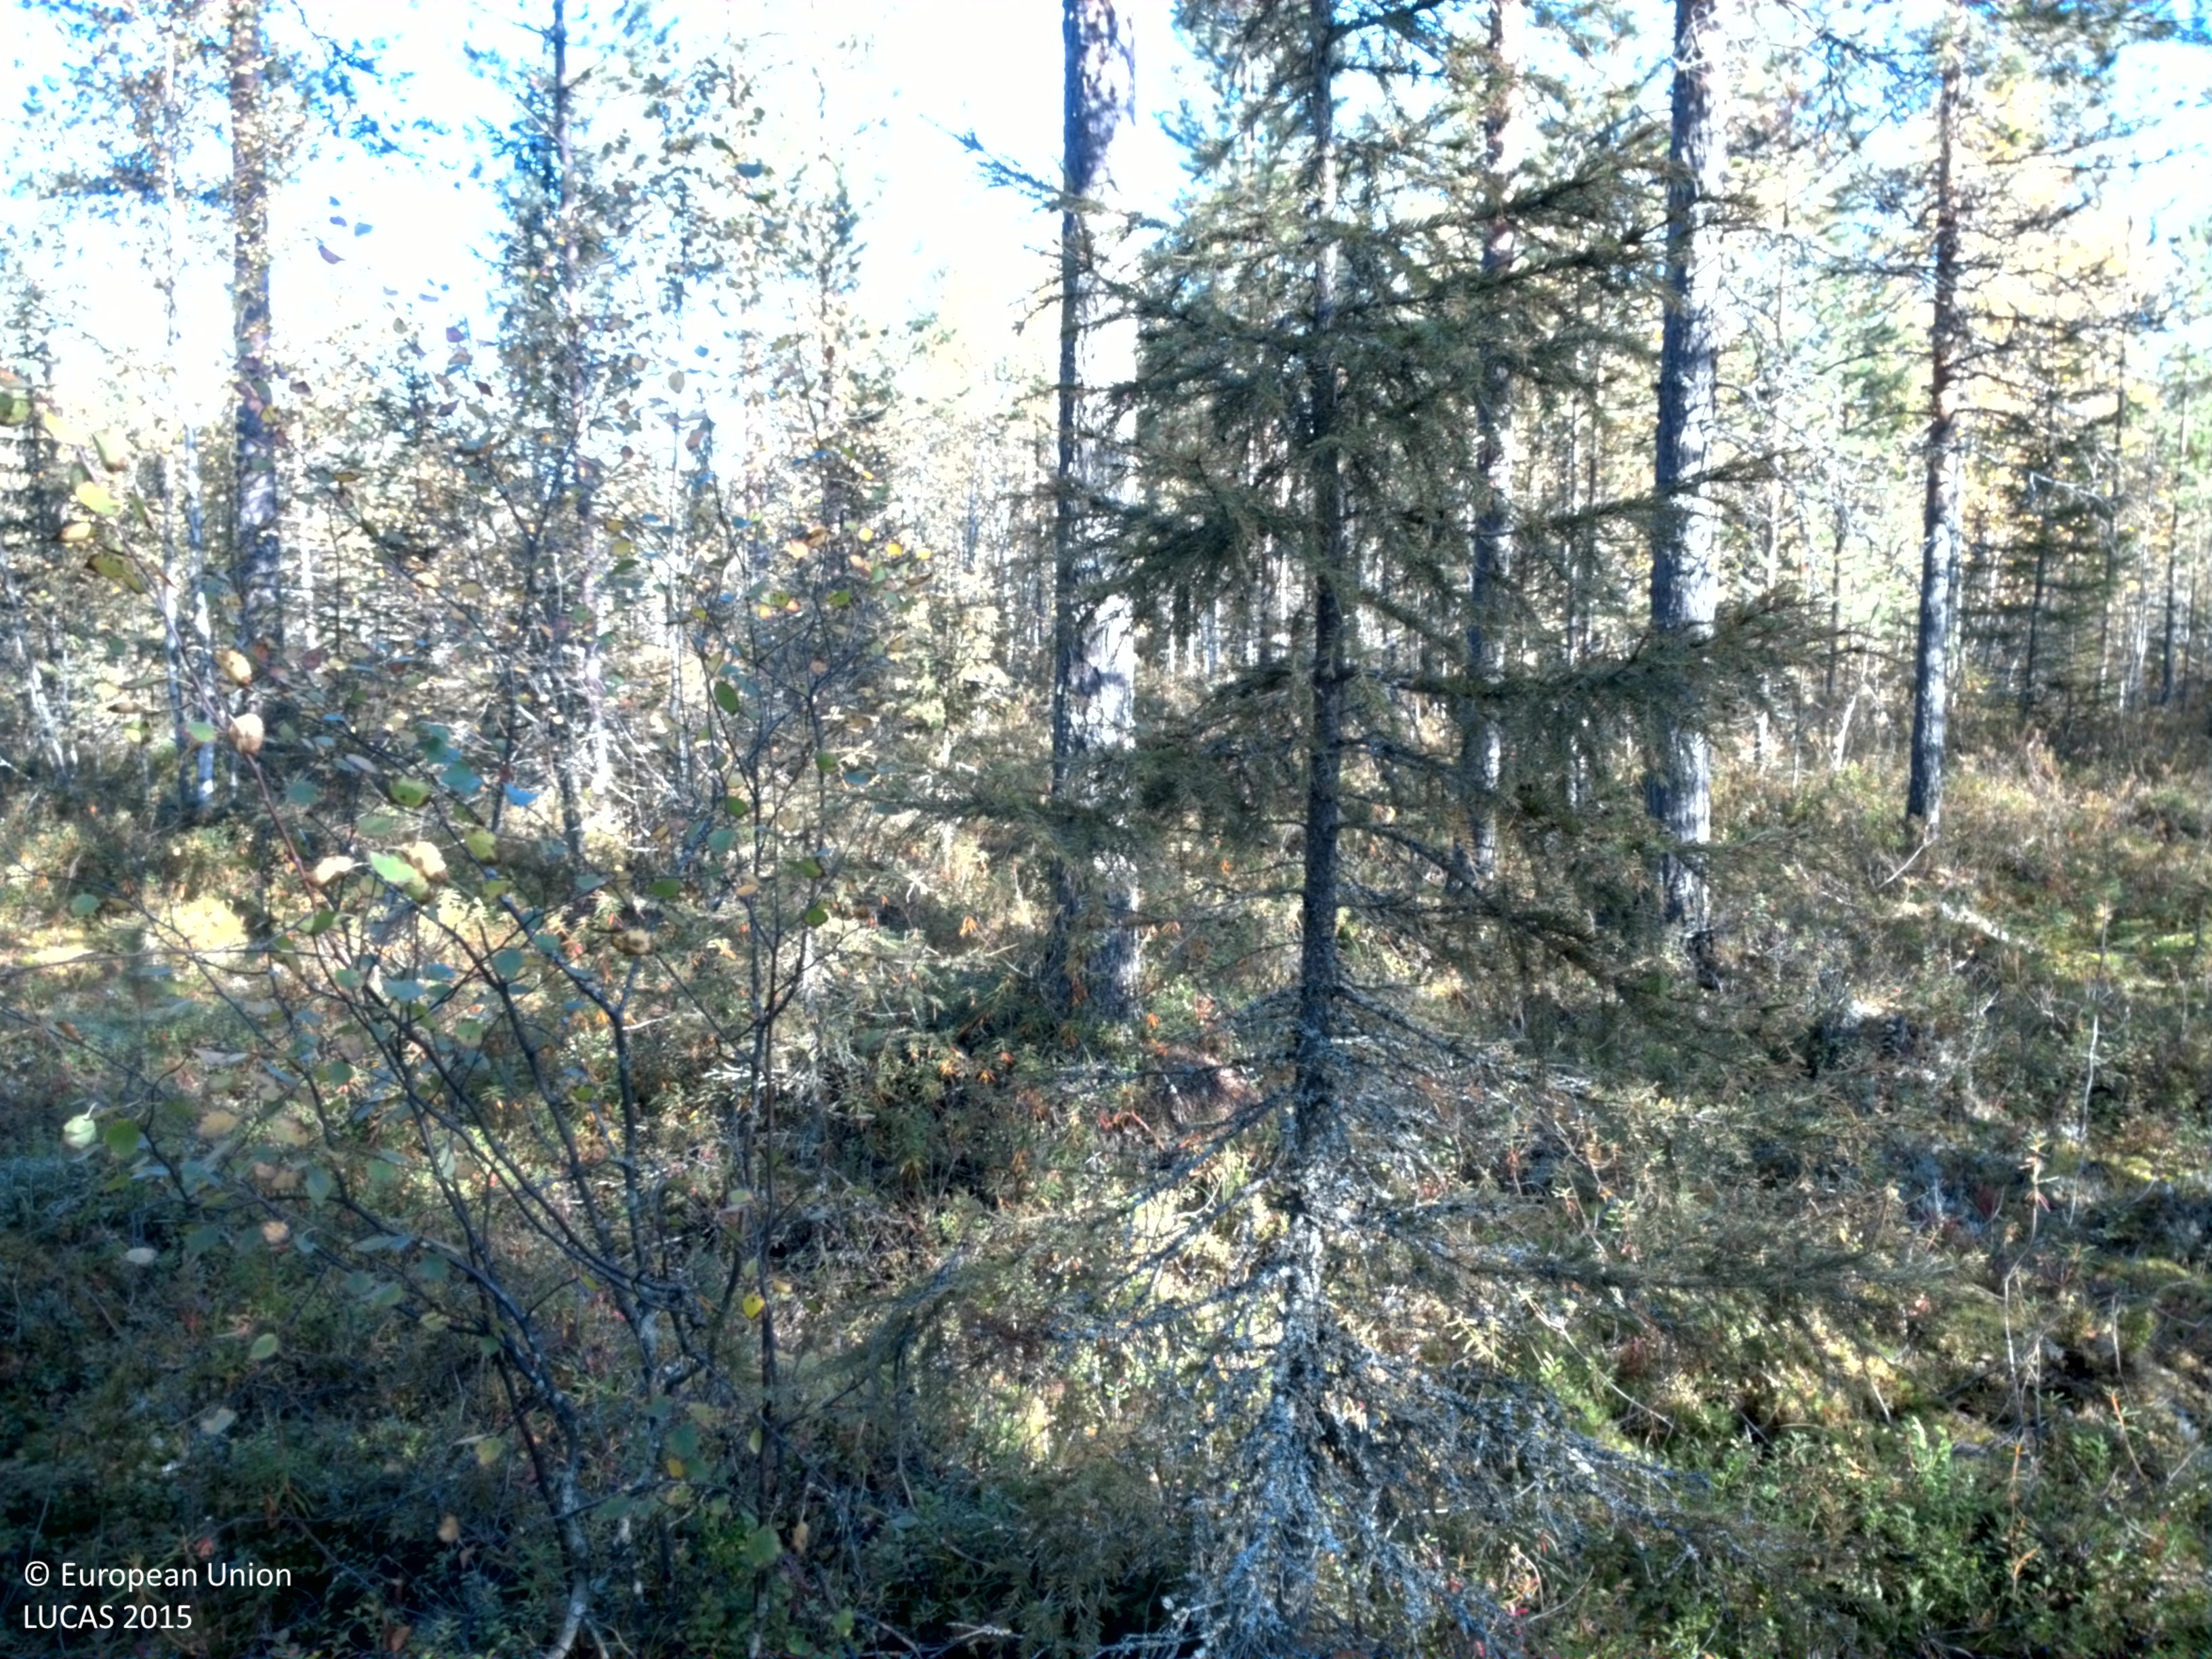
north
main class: Woodland
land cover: Pine dominated mixed woodland
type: boreal forest
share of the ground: 25 - 50 %
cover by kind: shrubs 60 %, coniferous forest trees 25 %, broadleaved forest trees 10 %, lichens and mosses 5 %
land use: Forestry
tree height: > 5 m
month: September
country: SE
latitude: 65.8523
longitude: 22.1787
